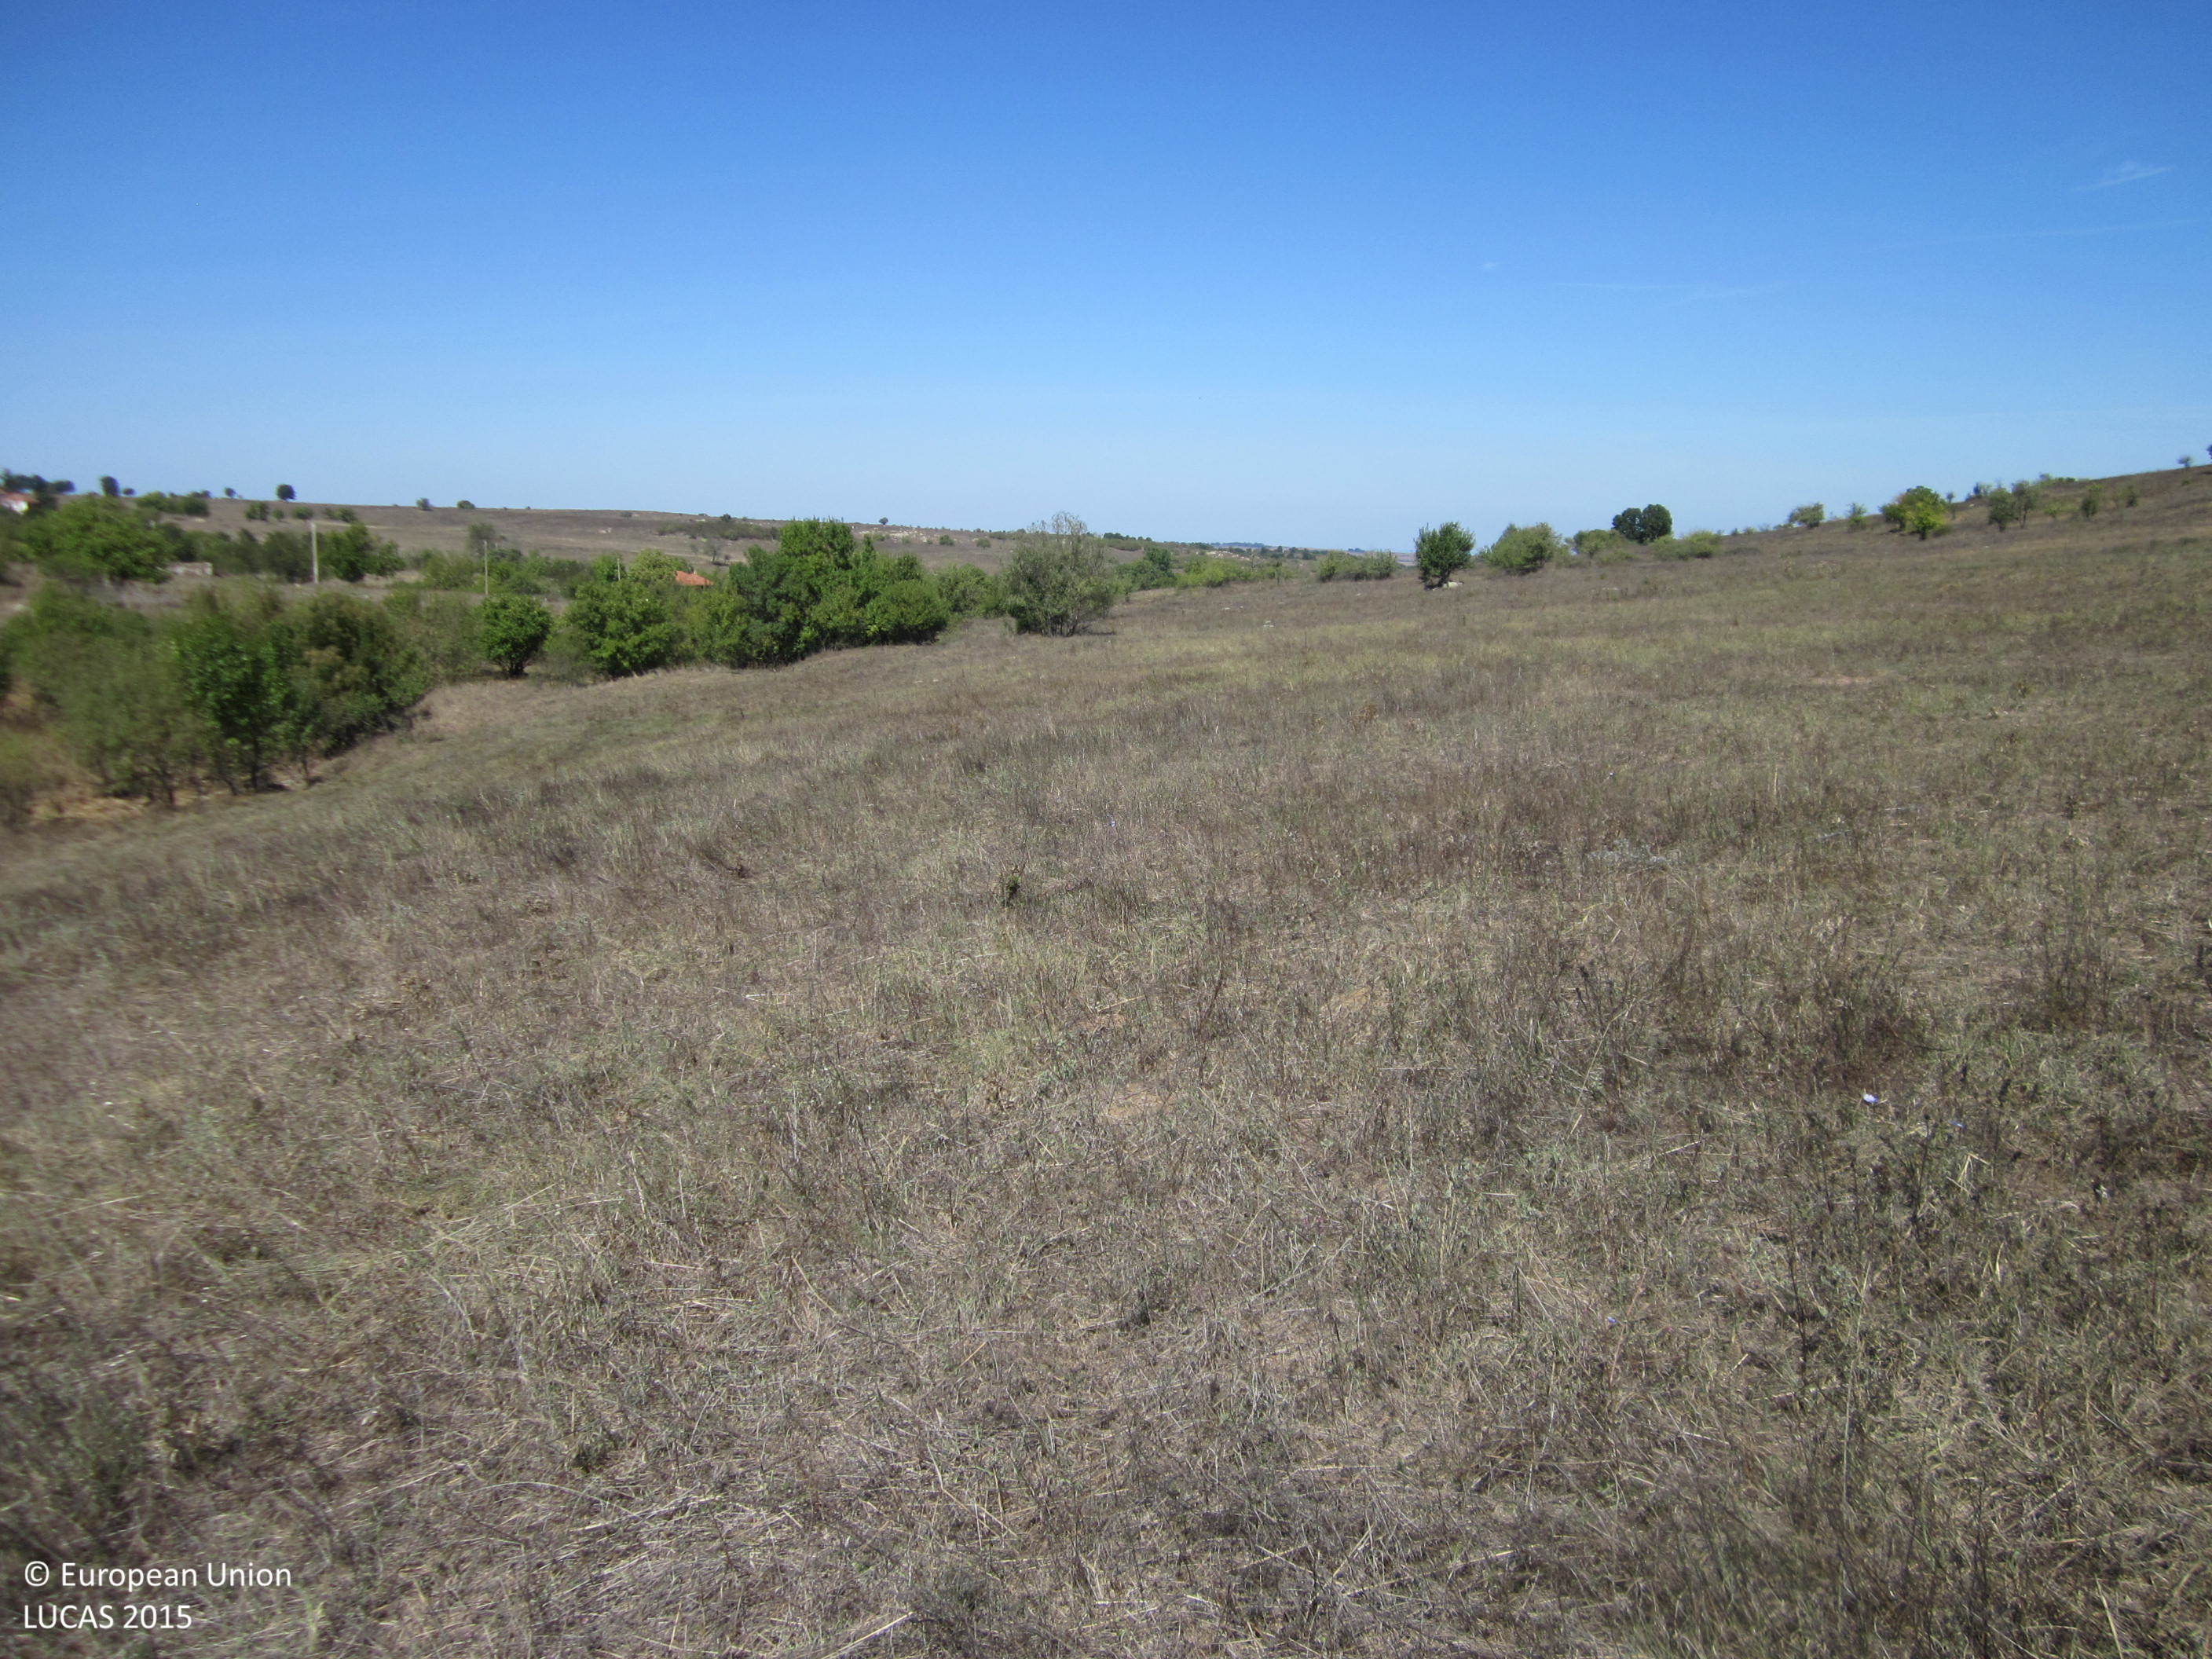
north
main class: Grassland
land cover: Grassland without tree/shrub cover
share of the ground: > 75 %
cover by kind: herbaceous plants 100 %
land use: Agriculture (excluding fallow land and kitchen gardens)
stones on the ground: < 10 %
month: September
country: BG
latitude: 42.2565
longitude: 26.9864
